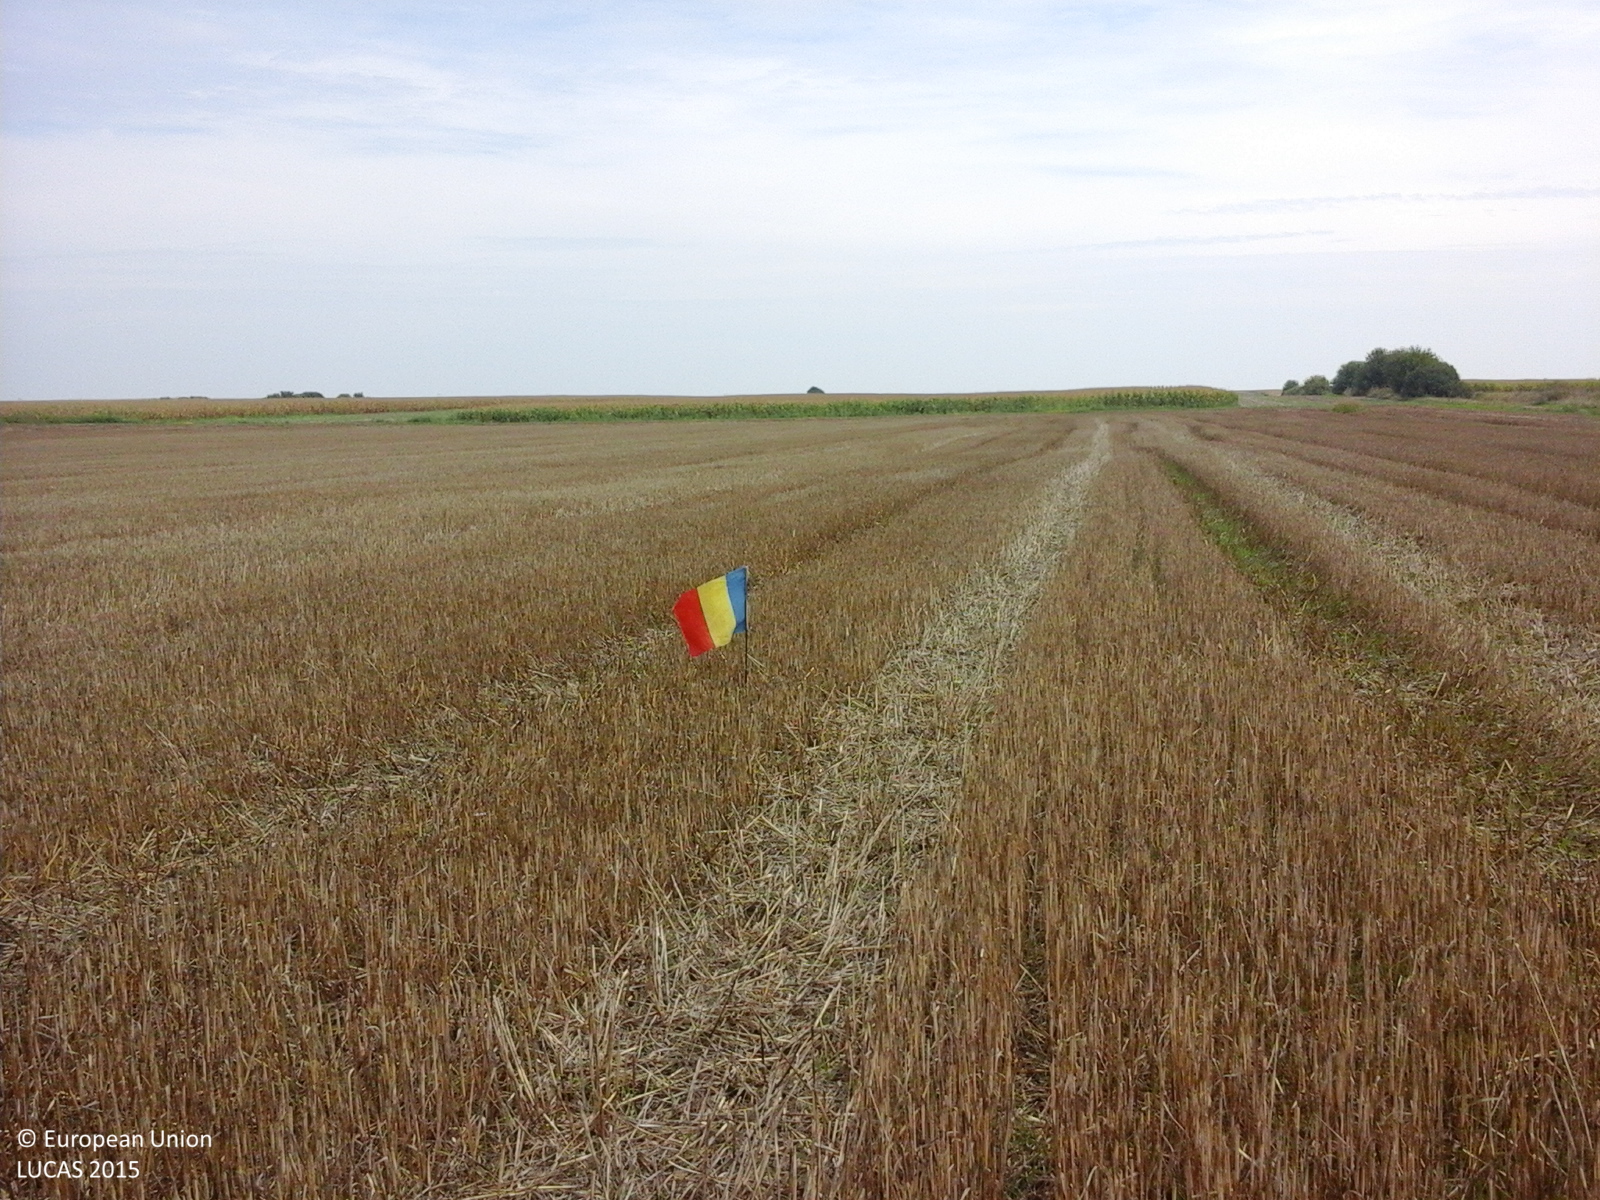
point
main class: Cropland
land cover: Common wheat
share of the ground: > 75 %
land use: Agriculture (excluding fallow land and kitchen gardens)
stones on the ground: < 10 %
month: August
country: RO
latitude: 46.2000
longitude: 20.8234
